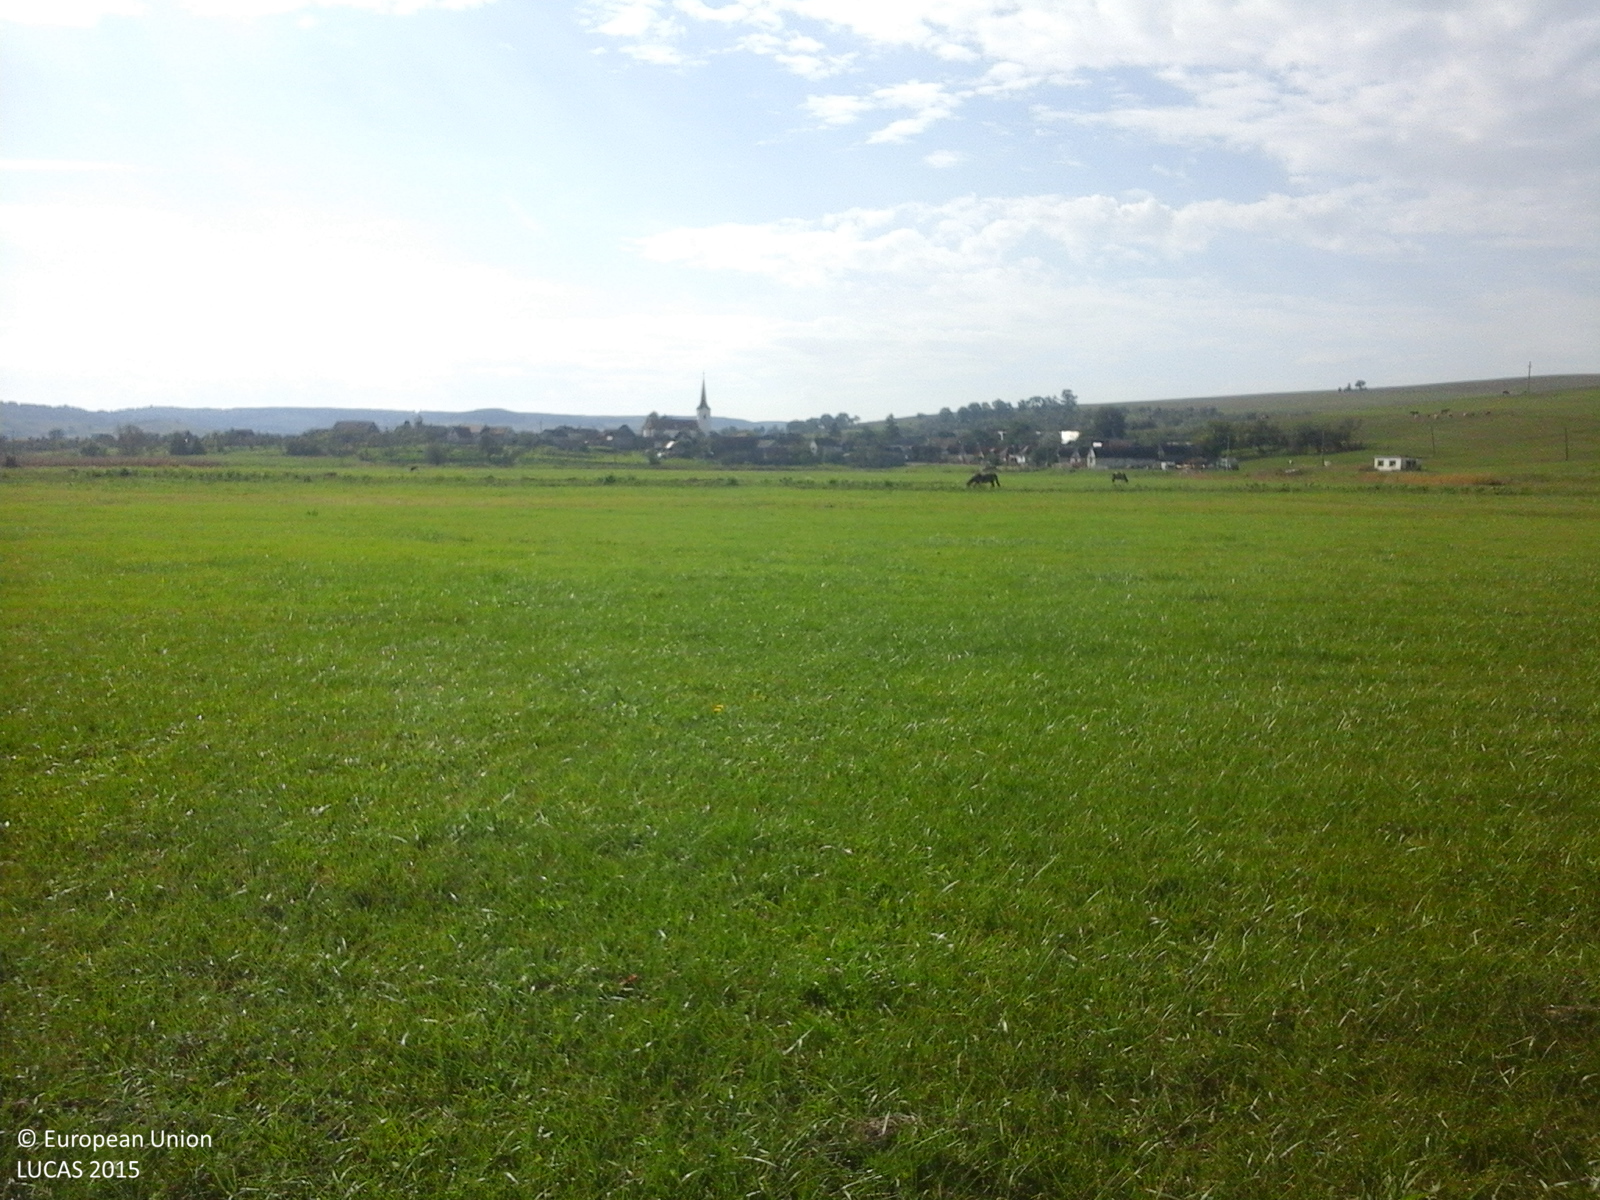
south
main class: Grassland
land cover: Grassland without tree/shrub cover
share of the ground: > 75 %
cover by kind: herbaceous plants 100 %
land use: Agriculture (excluding fallow land and kitchen gardens)
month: October
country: RO
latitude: 46.2011
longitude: 25.3830
